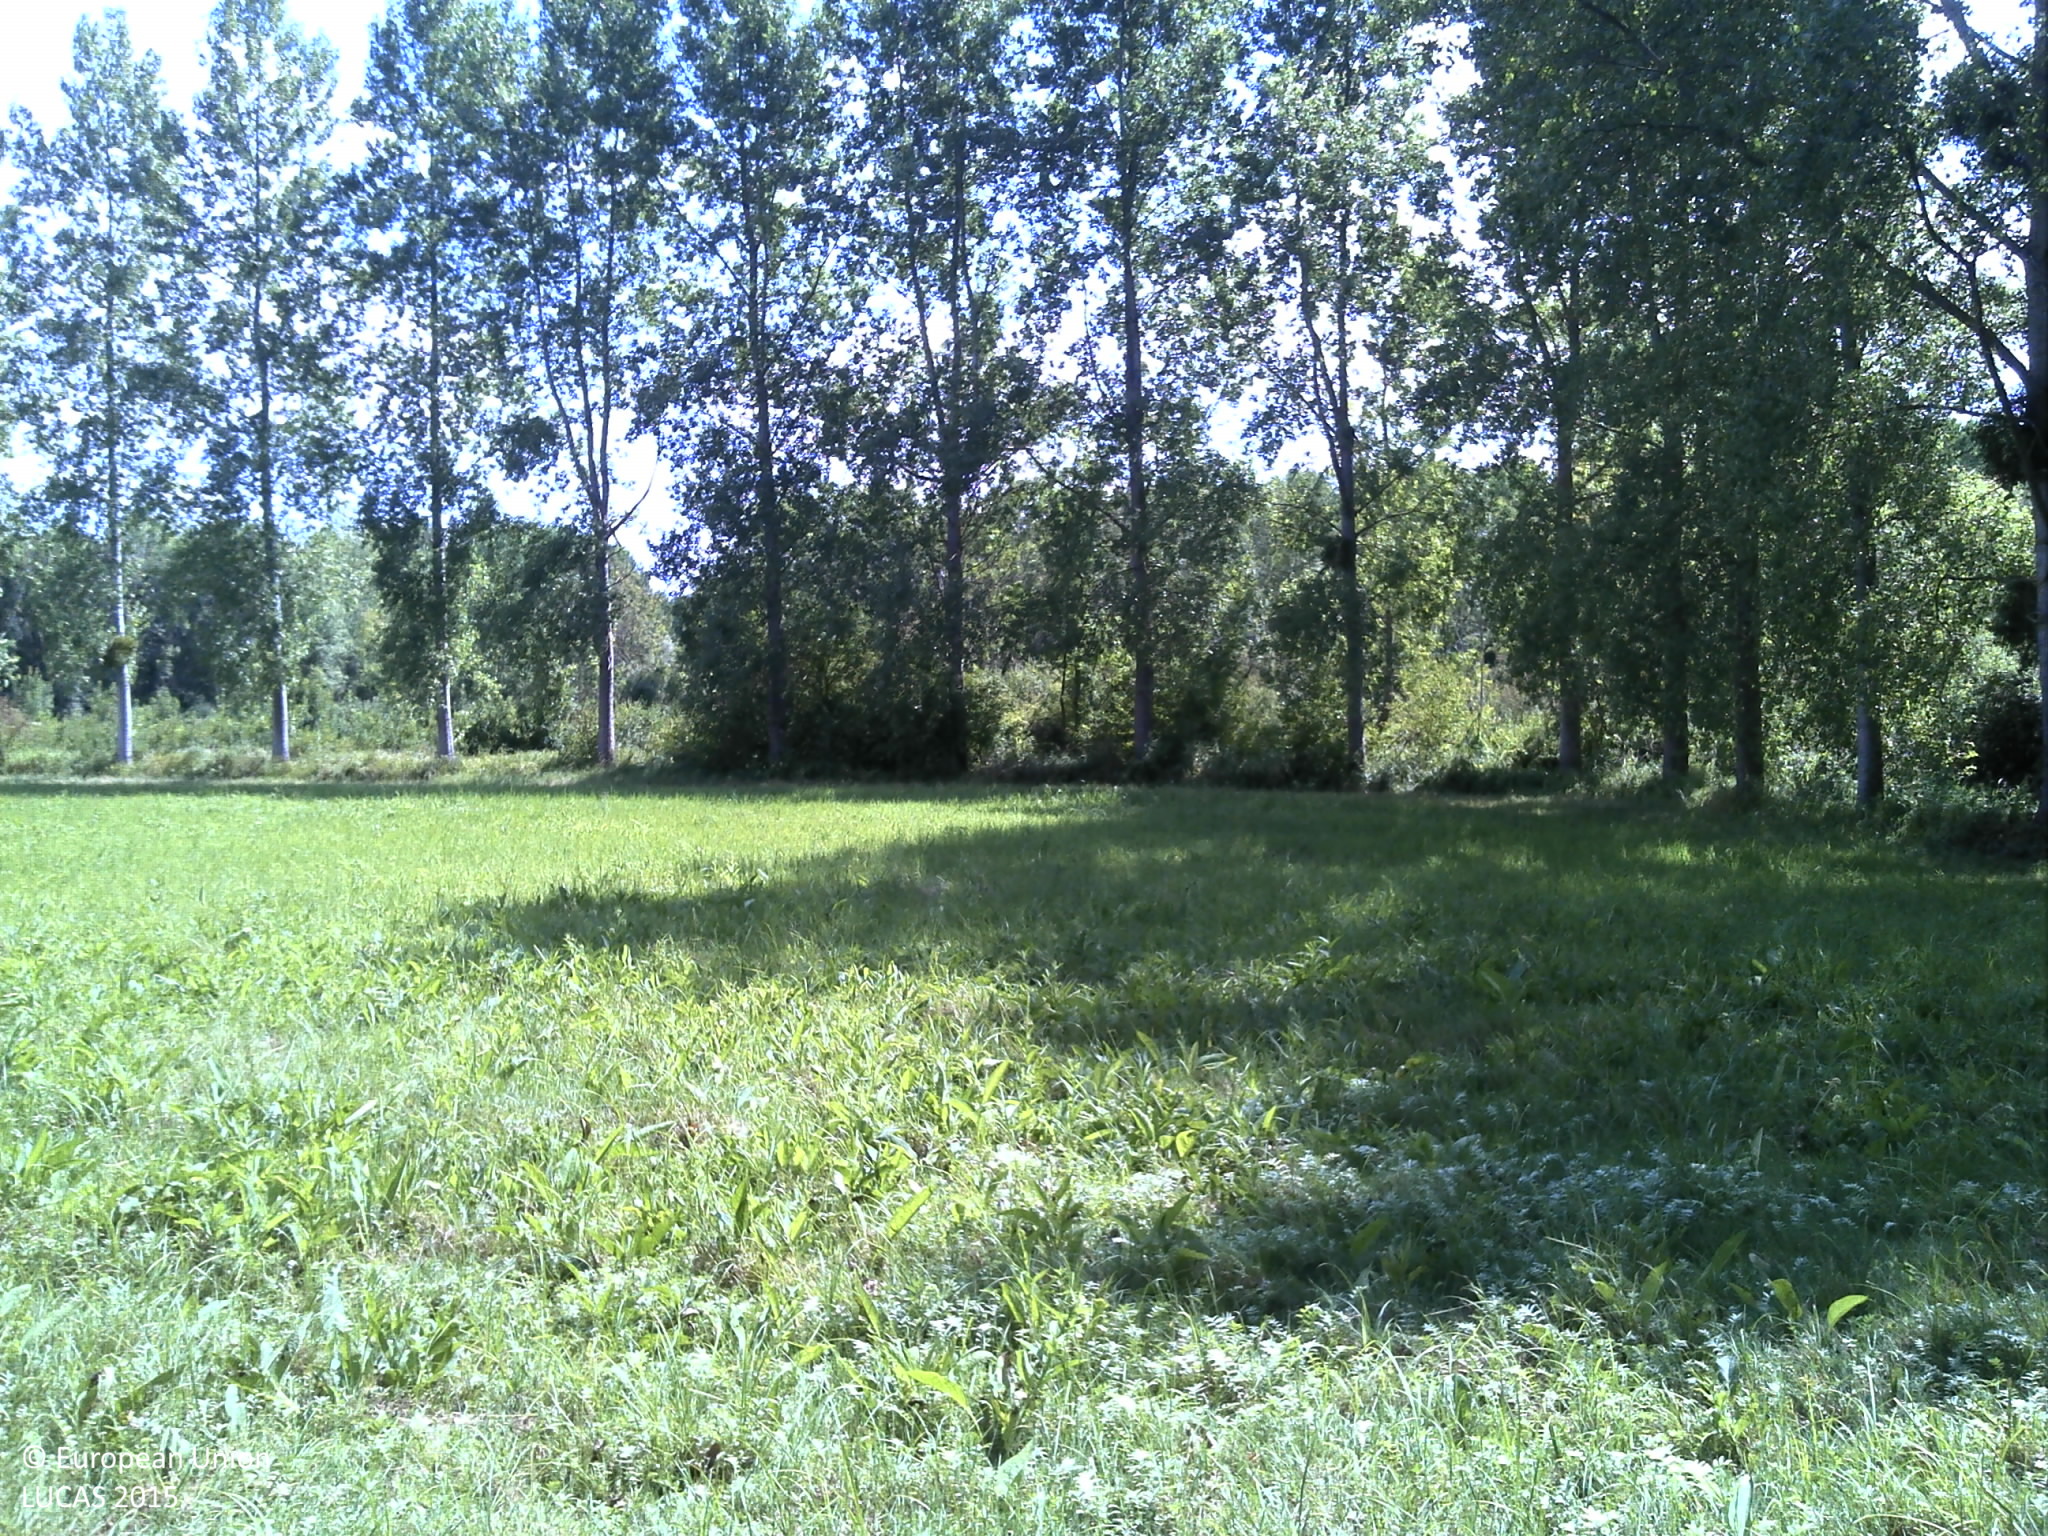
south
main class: Woodland
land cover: Broadleaved woodland
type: exotic forest
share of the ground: > 75 %
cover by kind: broadleaved forest trees 70 %, herbaceous plants 30 %
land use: Forestry
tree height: > 5 m
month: August
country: FR
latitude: 48.4806
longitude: 3.4596
